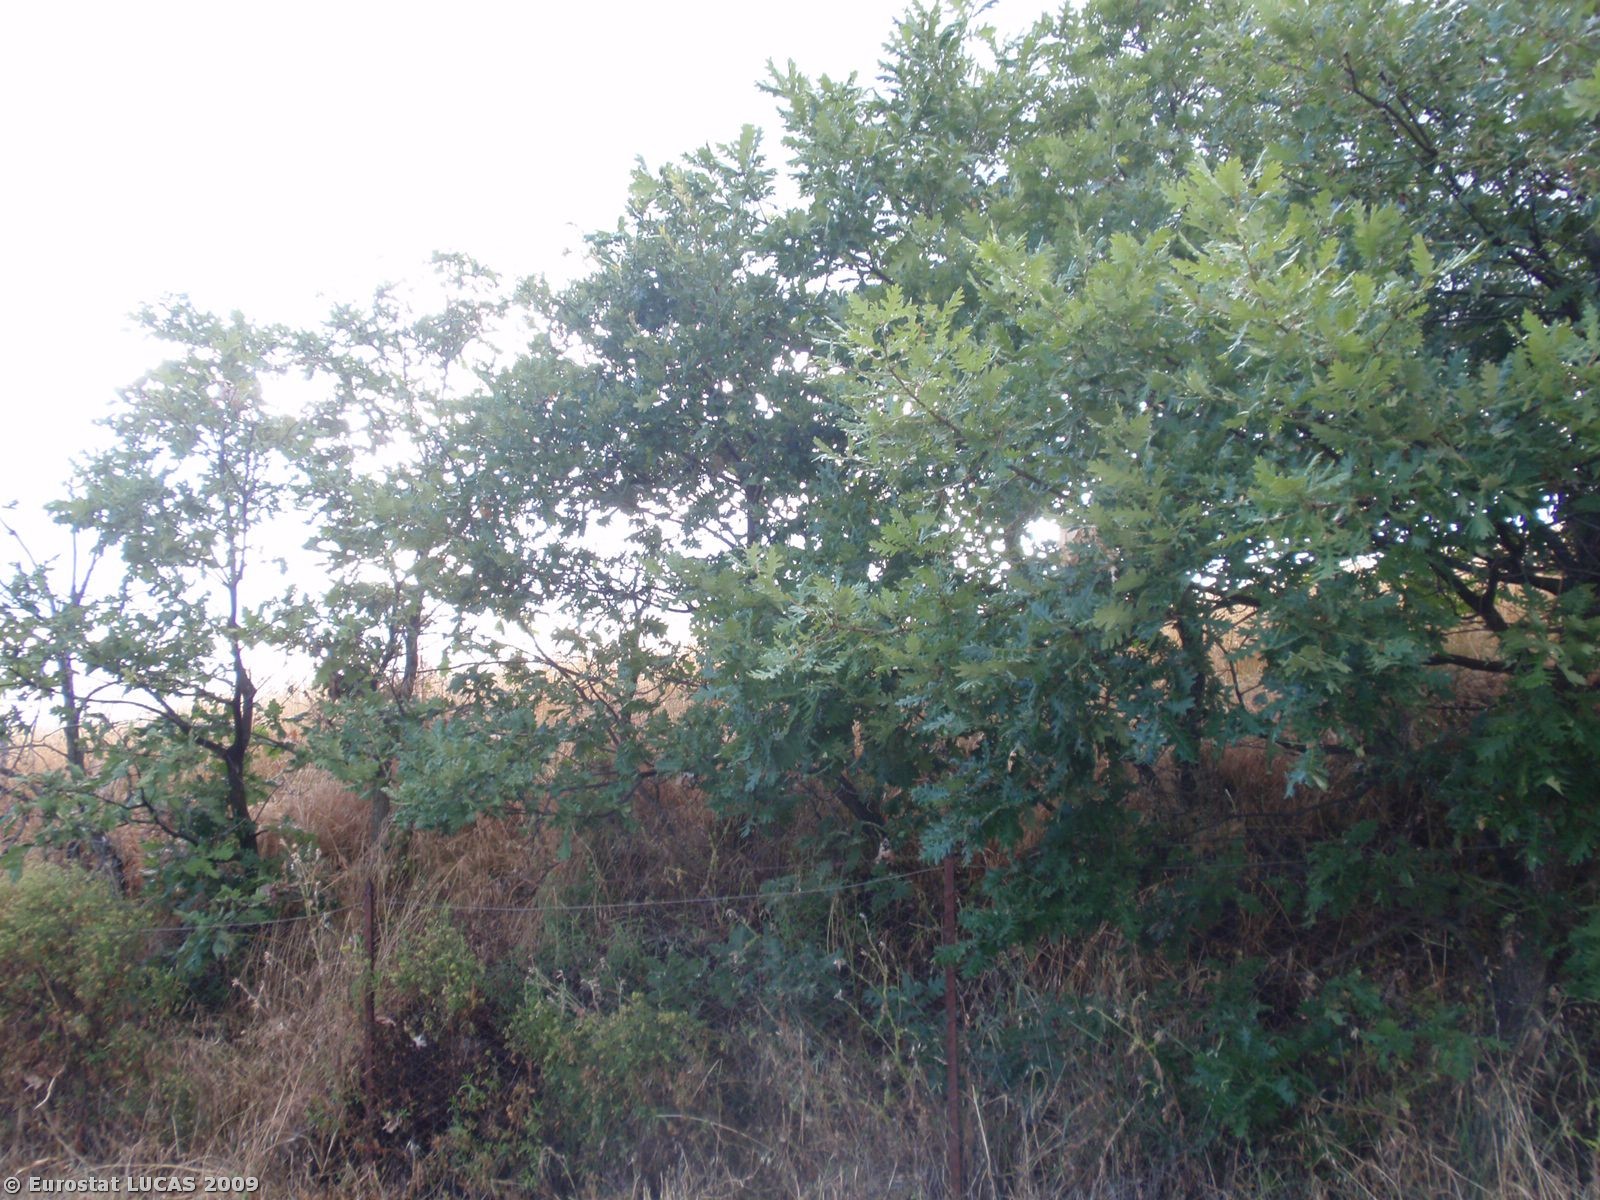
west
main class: Cropland
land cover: Temporary grasslands
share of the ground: < 10 %
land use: Agriculture (excluding fallow land and kitchen gardens)
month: June
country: IT
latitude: 40.2768
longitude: 16.1027
